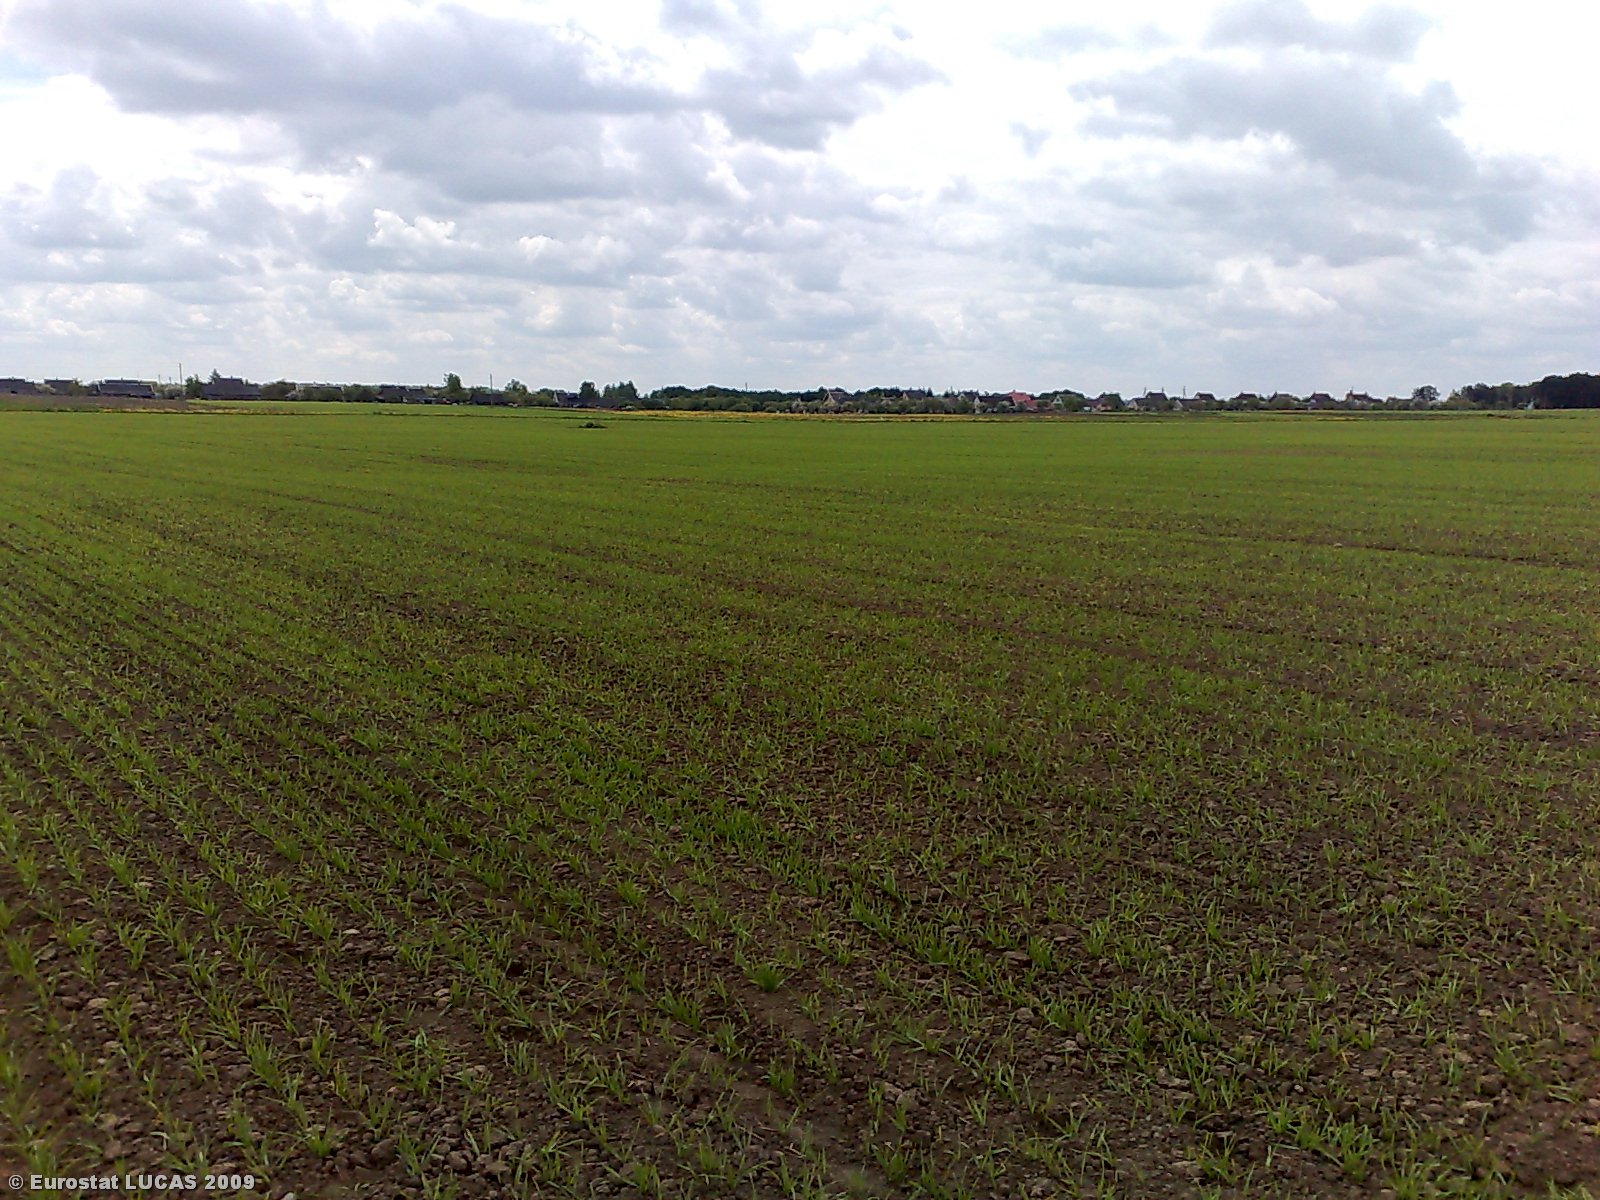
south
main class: Cropland
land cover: Barley
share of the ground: 25 - 50 %
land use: Agriculture (excluding fallow land and kitchen gardens)
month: May
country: LT
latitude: 55.6529
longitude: 23.8321
